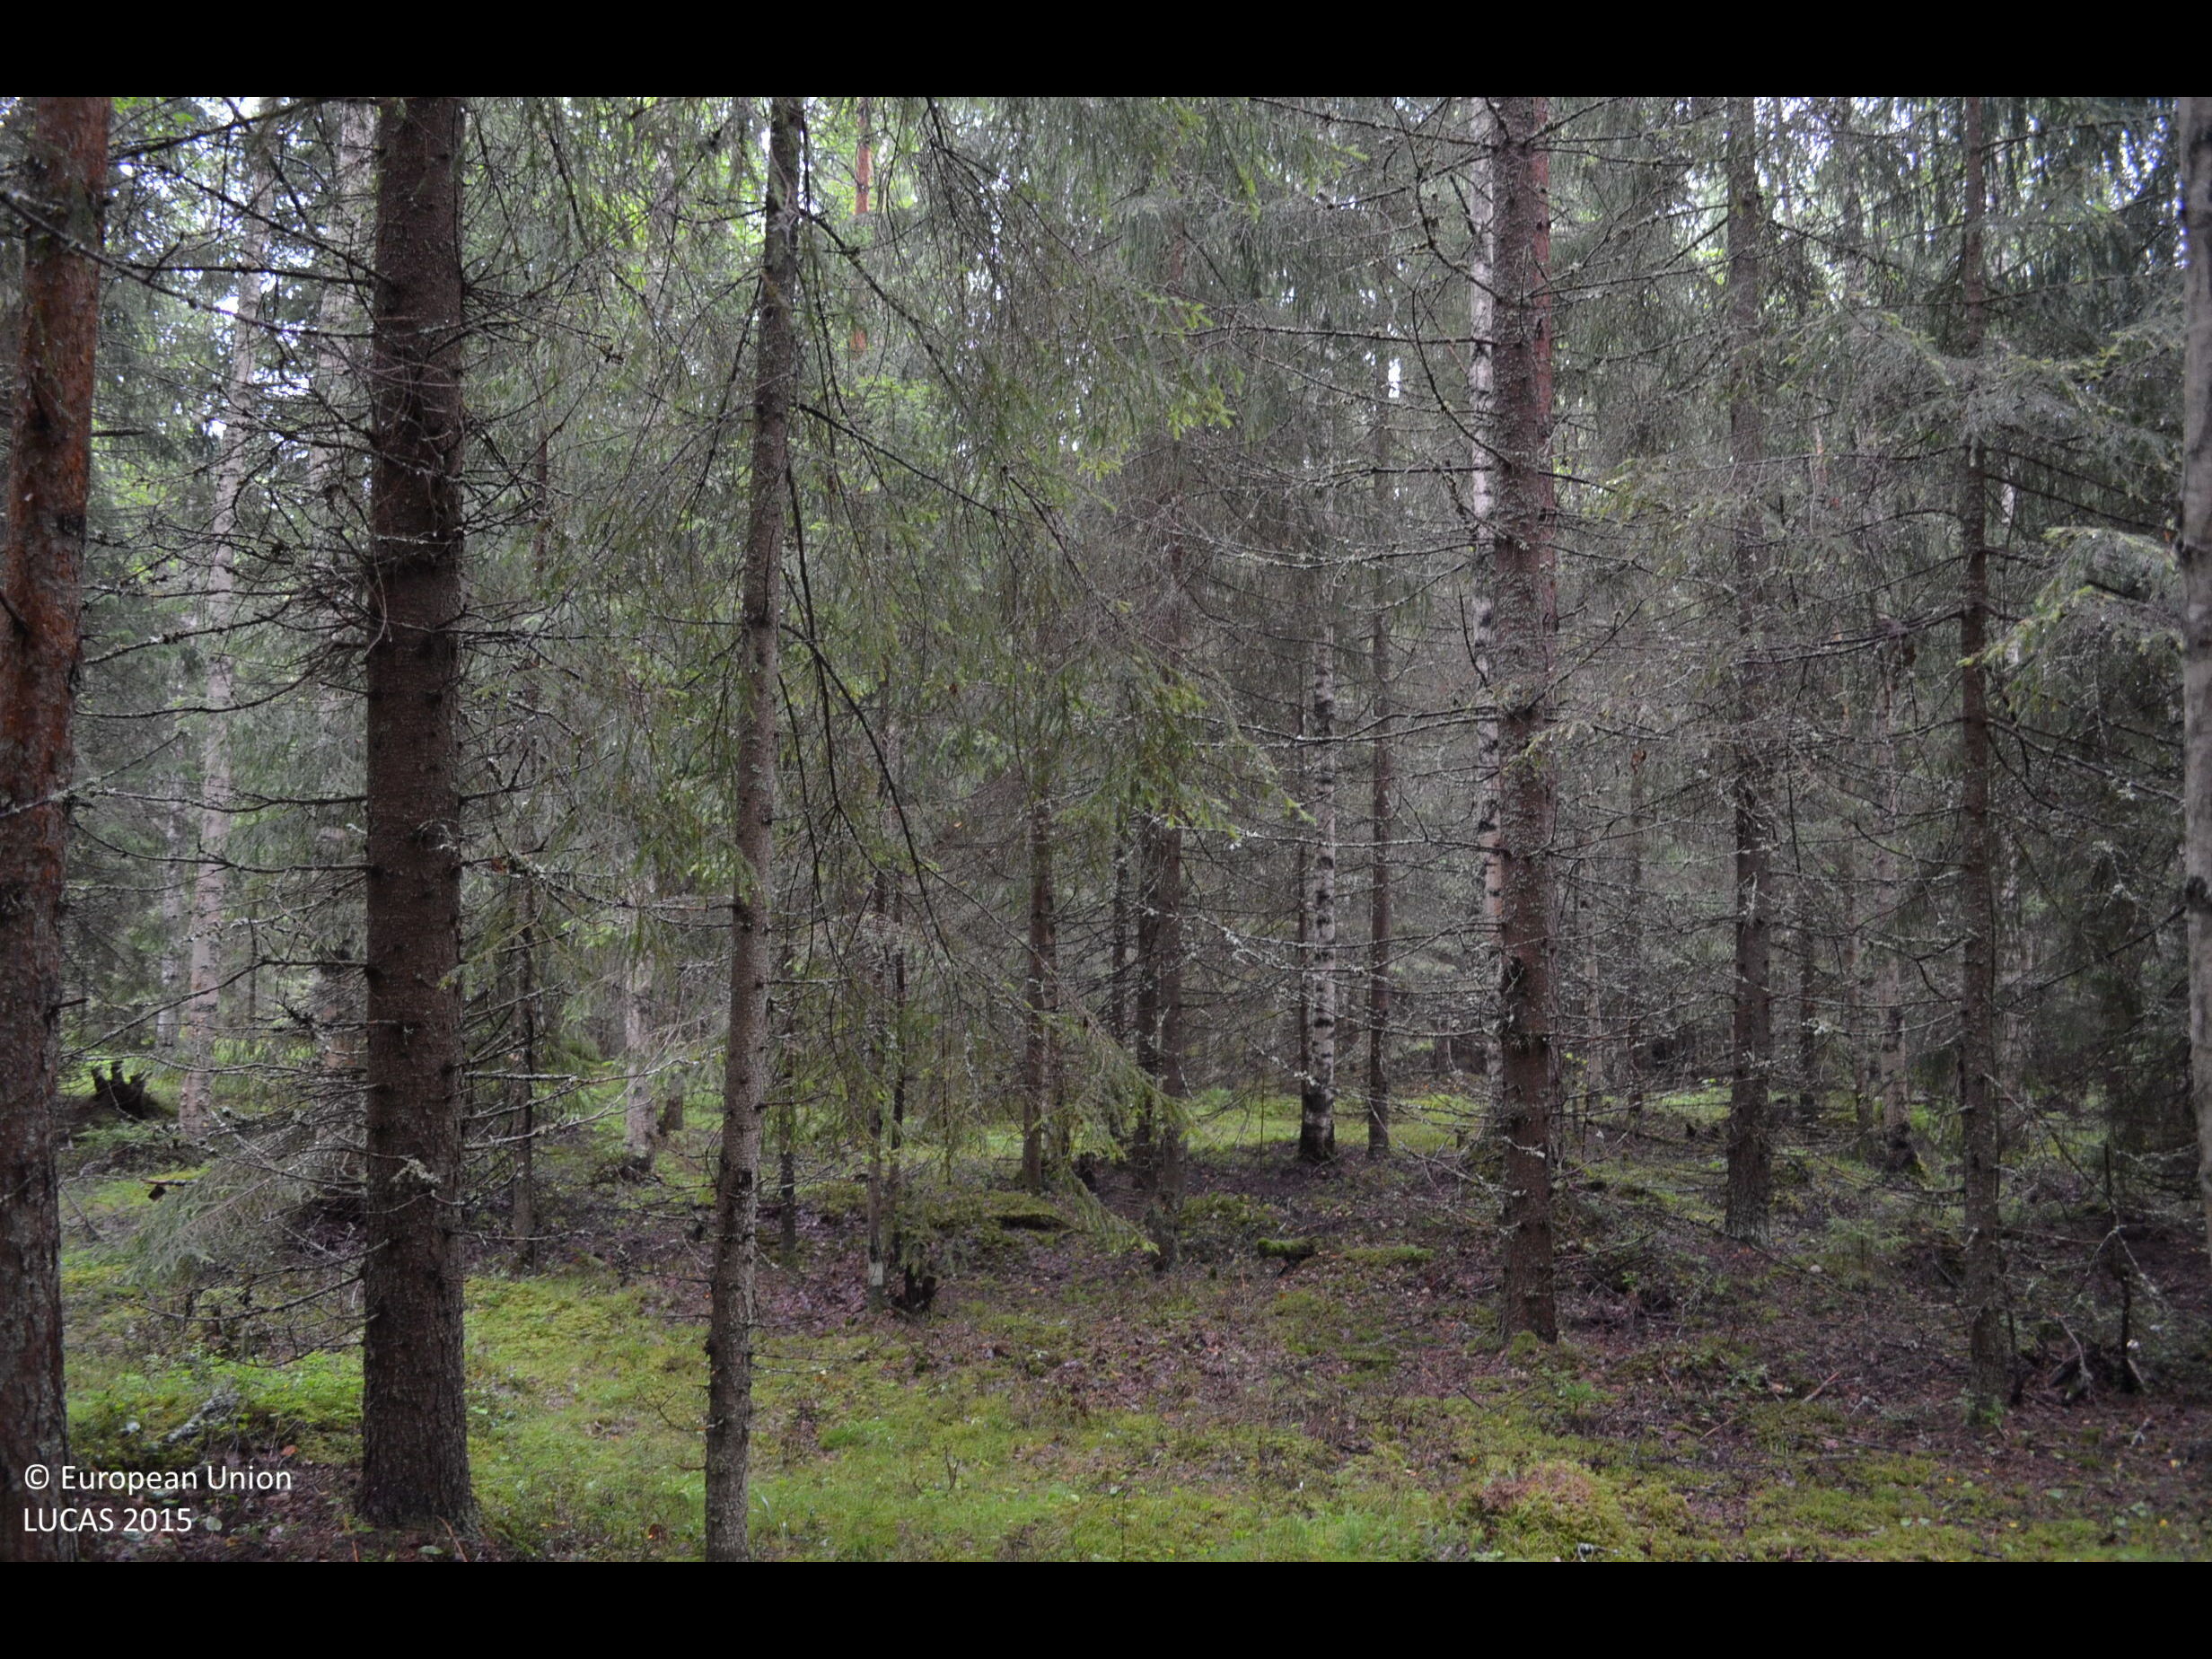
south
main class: Woodland
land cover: Spruce dominated mixed woodland
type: boreal forest
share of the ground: > 75 %
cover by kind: broadleaved forest trees 60 %, coniferous forest trees 30 %, shrubs 5 %, lichens and mosses 5 %
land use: Forestry
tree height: > 5 m
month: July
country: FI
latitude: 62.0082
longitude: 24.0076
